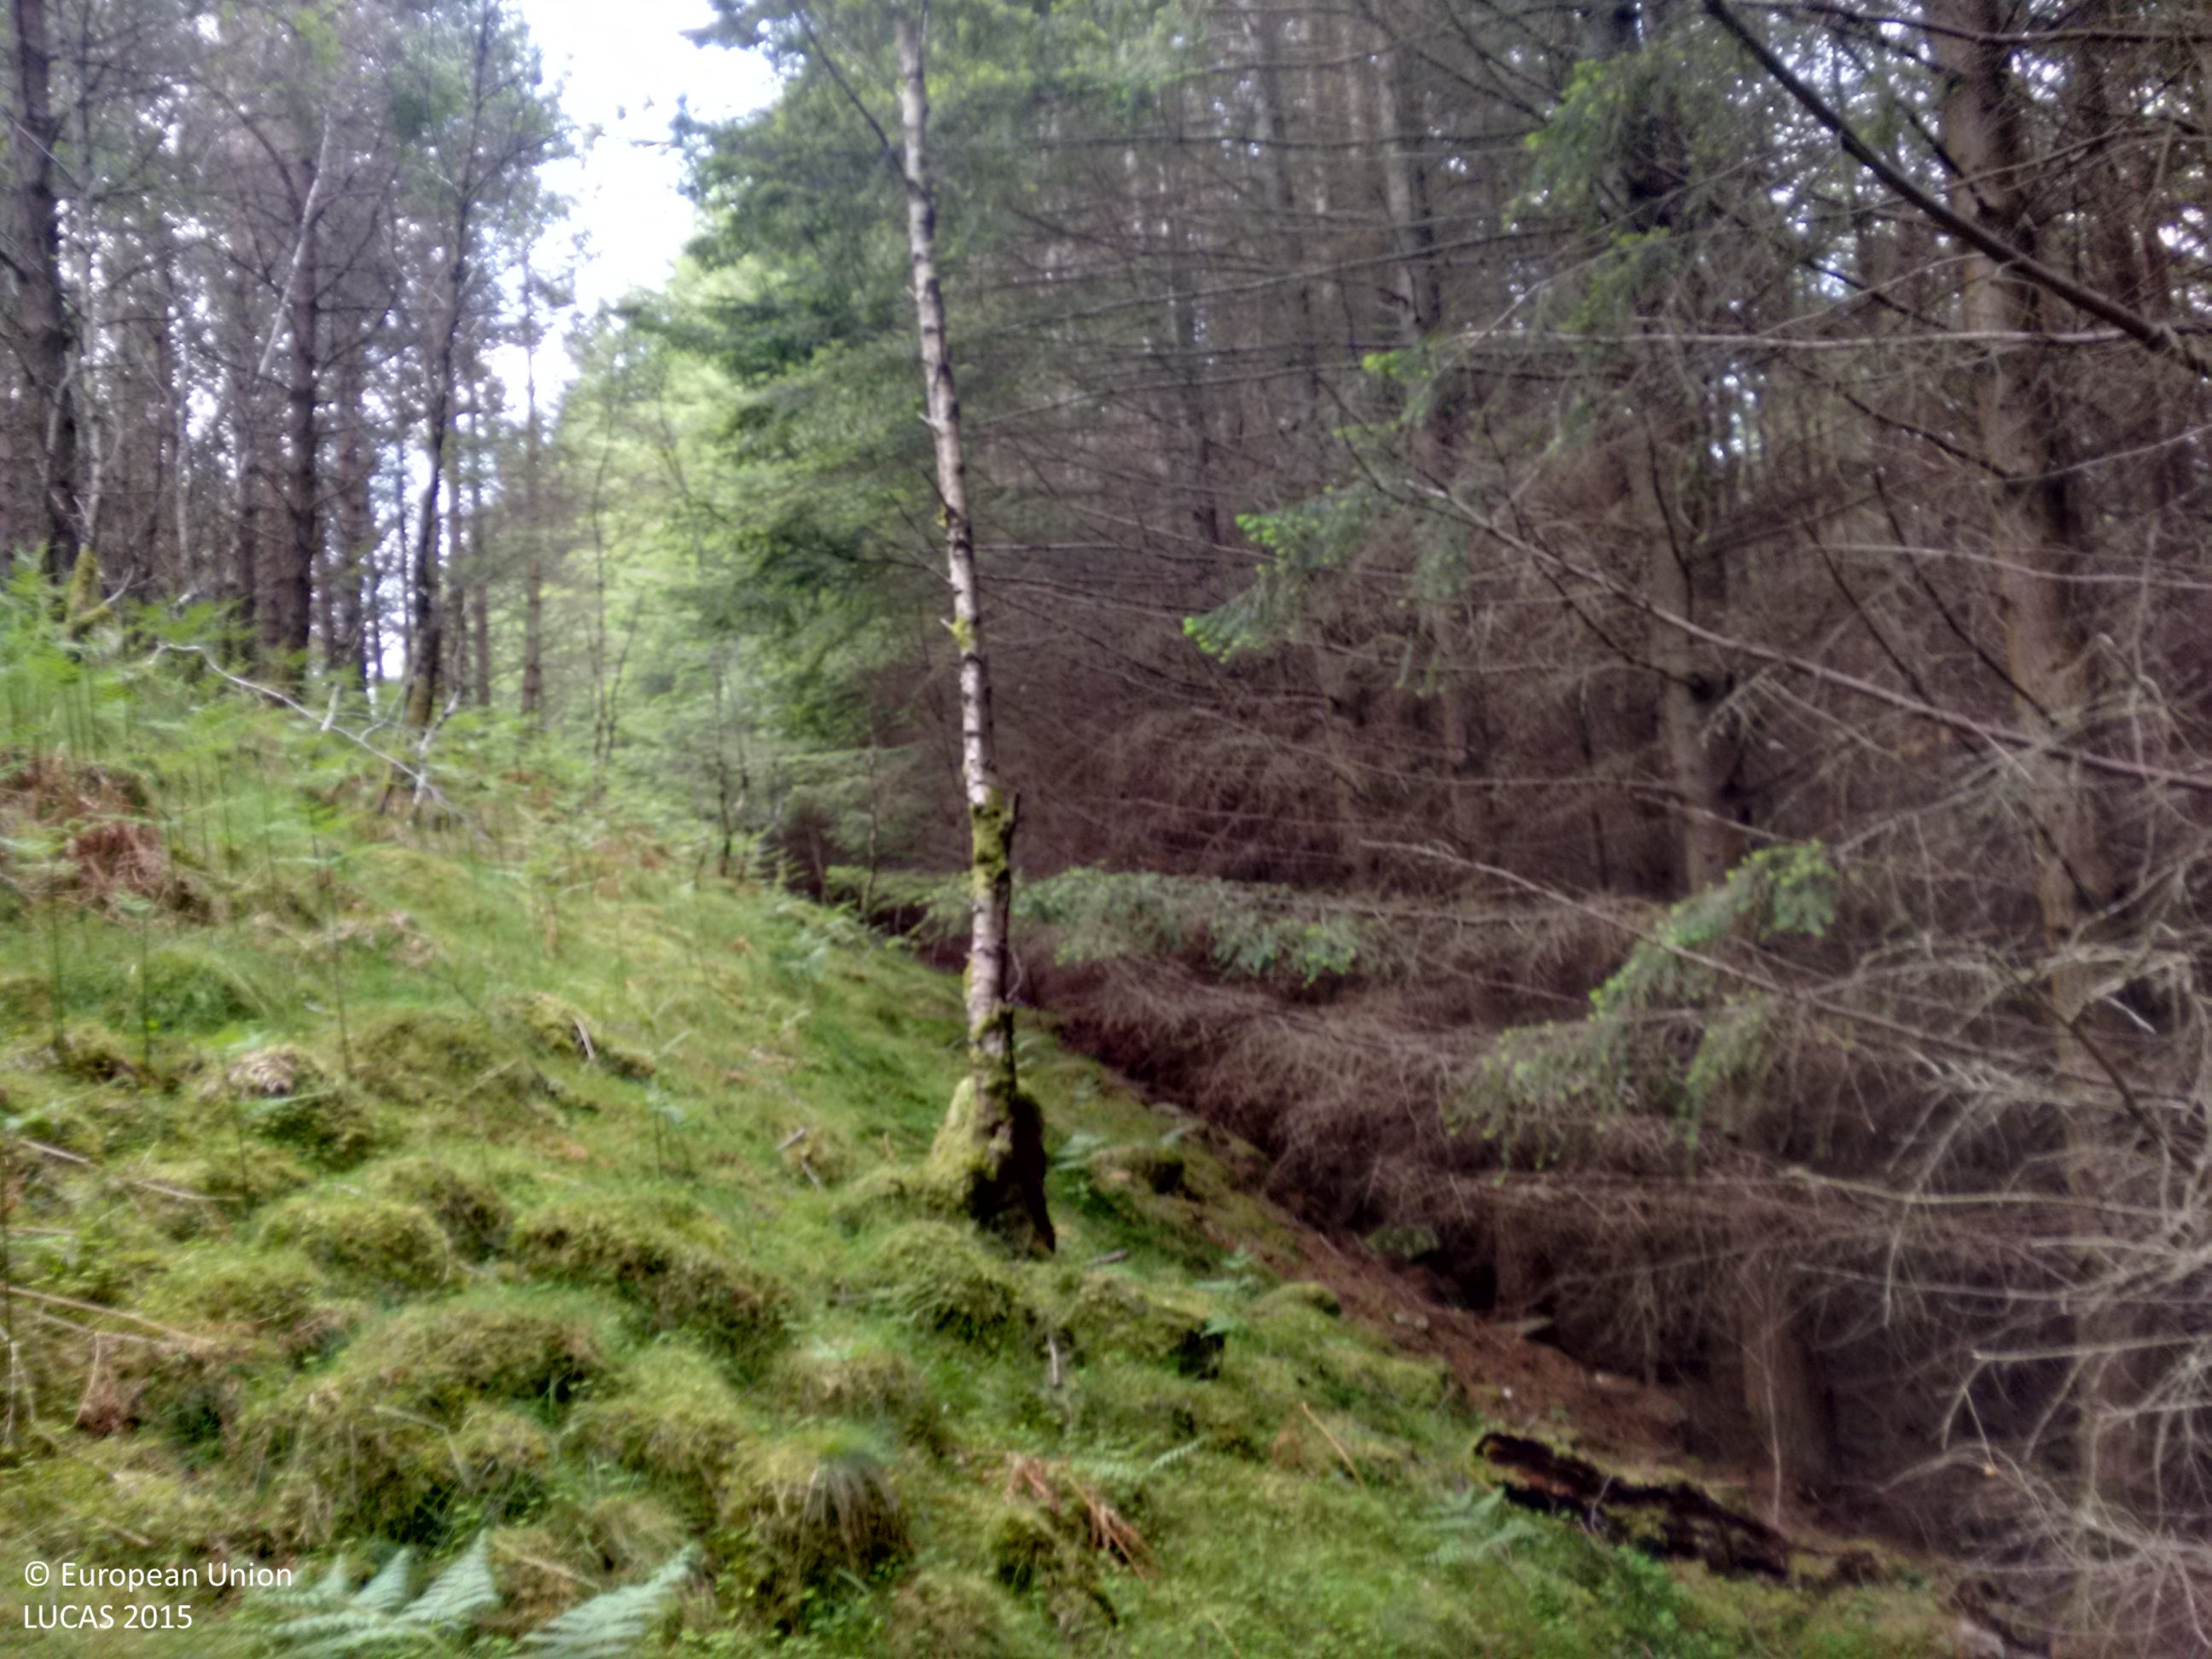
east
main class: Woodland
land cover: Spruce dominated coniferous woodland
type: exotic forest
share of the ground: > 75 %
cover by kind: coniferous forest trees 100 %
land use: Forestry
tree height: > 5 m
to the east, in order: Spruce dominated coniferous woodland; Pine dominated coniferous woodland
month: July
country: GB
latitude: 56.7146
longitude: -3.9873
